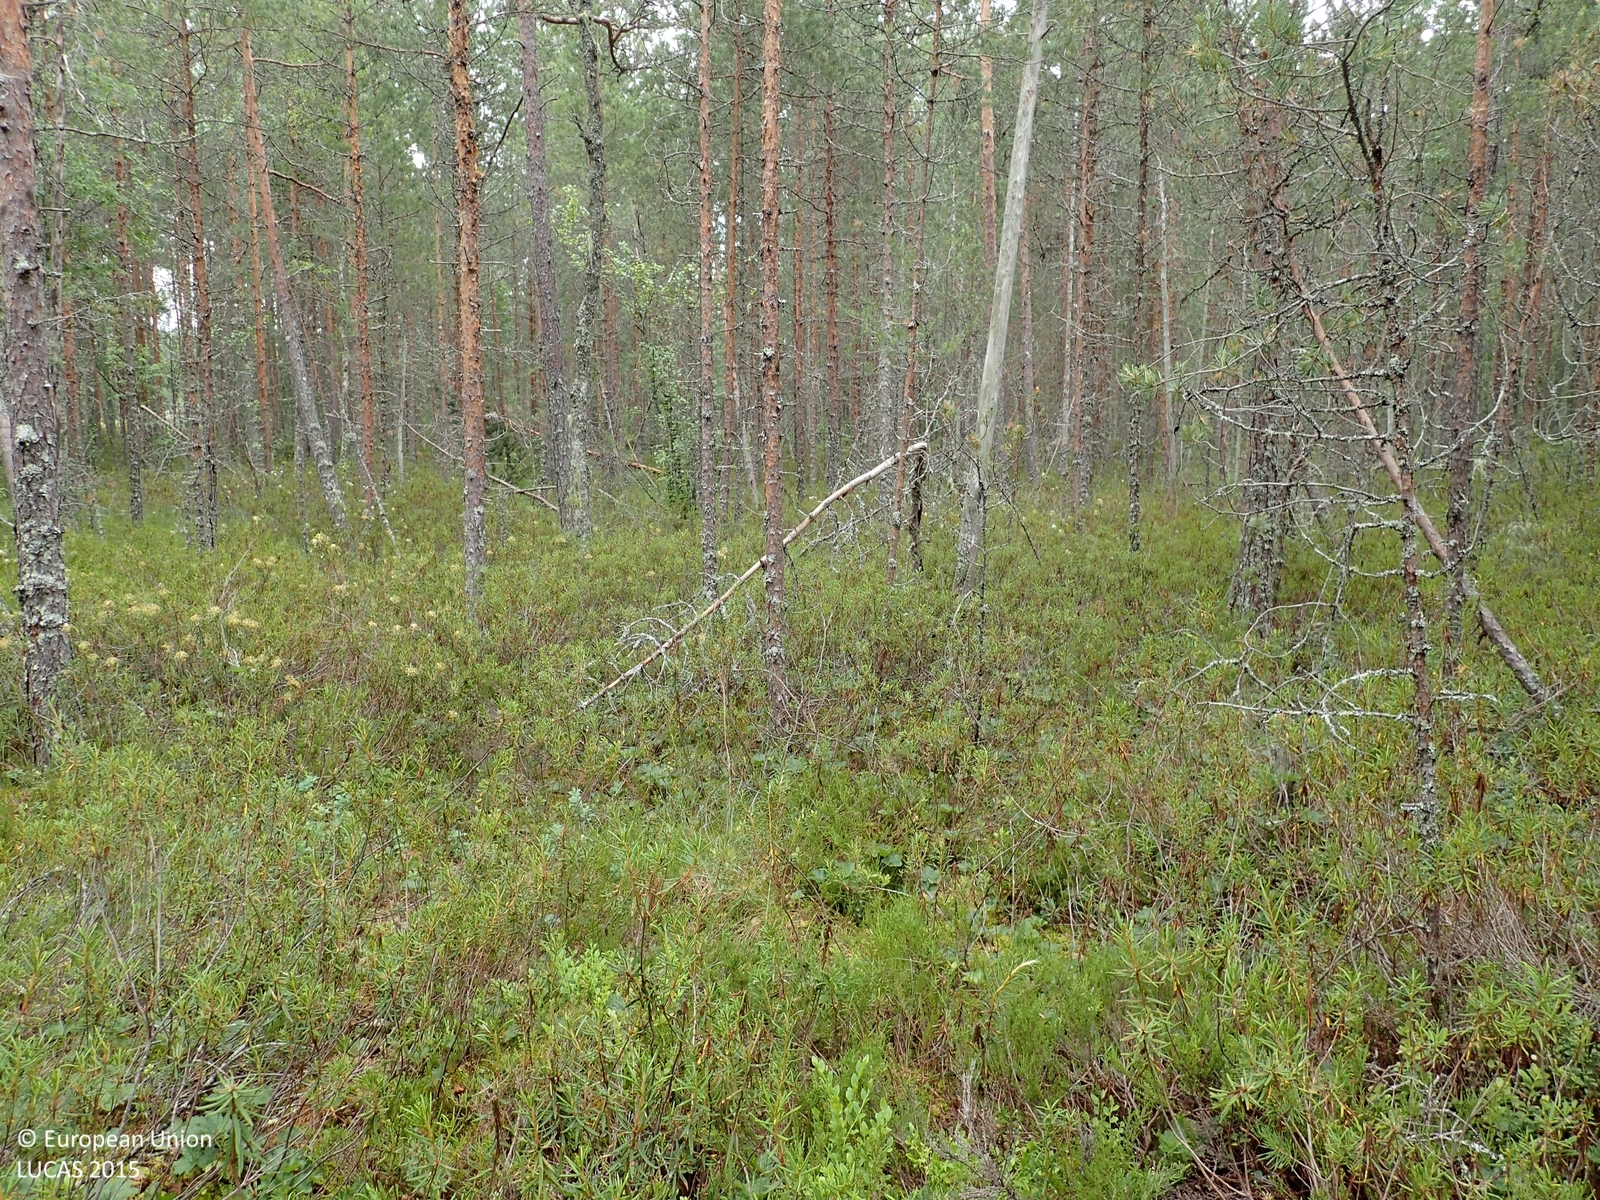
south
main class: Woodland
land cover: Pine dominated coniferous woodland
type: mire and swamp forests
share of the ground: 50 - 75 %
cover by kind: coniferous forest trees 50 %, shrubs 50 %
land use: Forestry
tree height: < 5 m
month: July
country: FI
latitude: 62.9321
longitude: 21.8031
